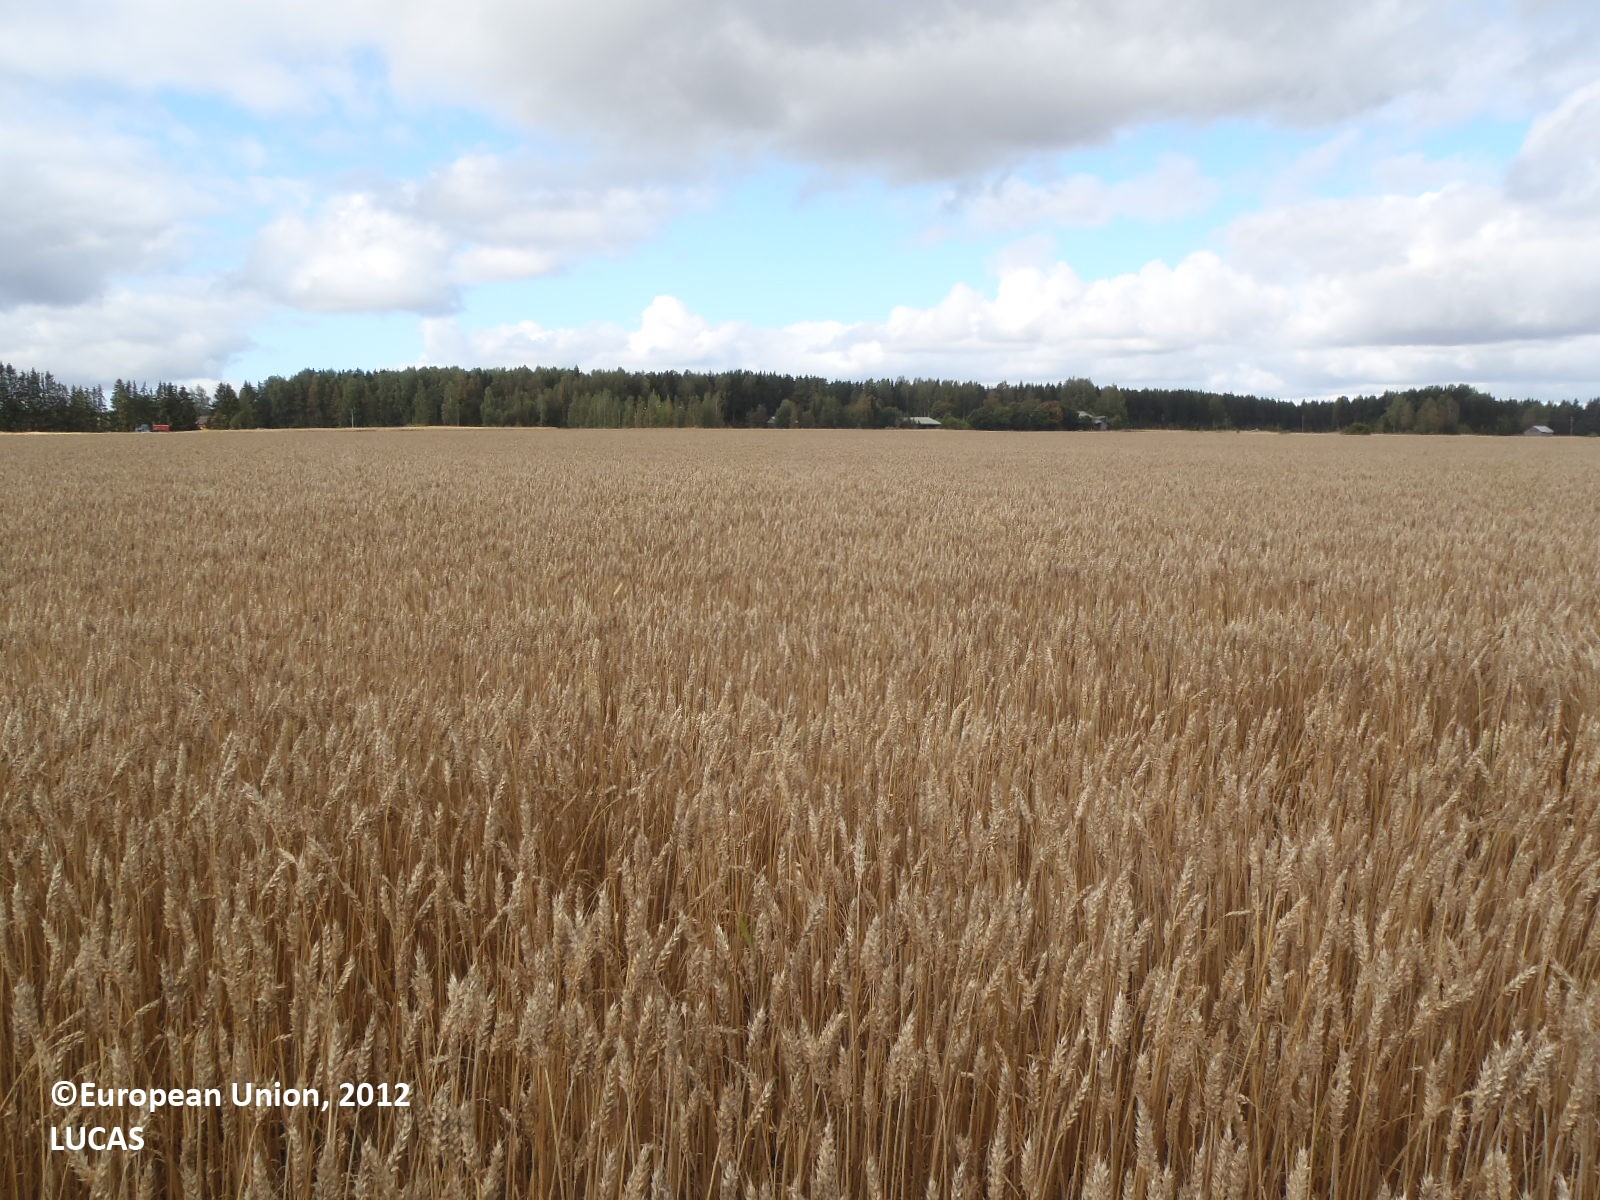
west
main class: Cropland
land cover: Common wheat
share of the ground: > 75 %
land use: Agriculture (excluding fallow land and kitchen gardens)
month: September
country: FI
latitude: 61.2708
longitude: 22.6560
